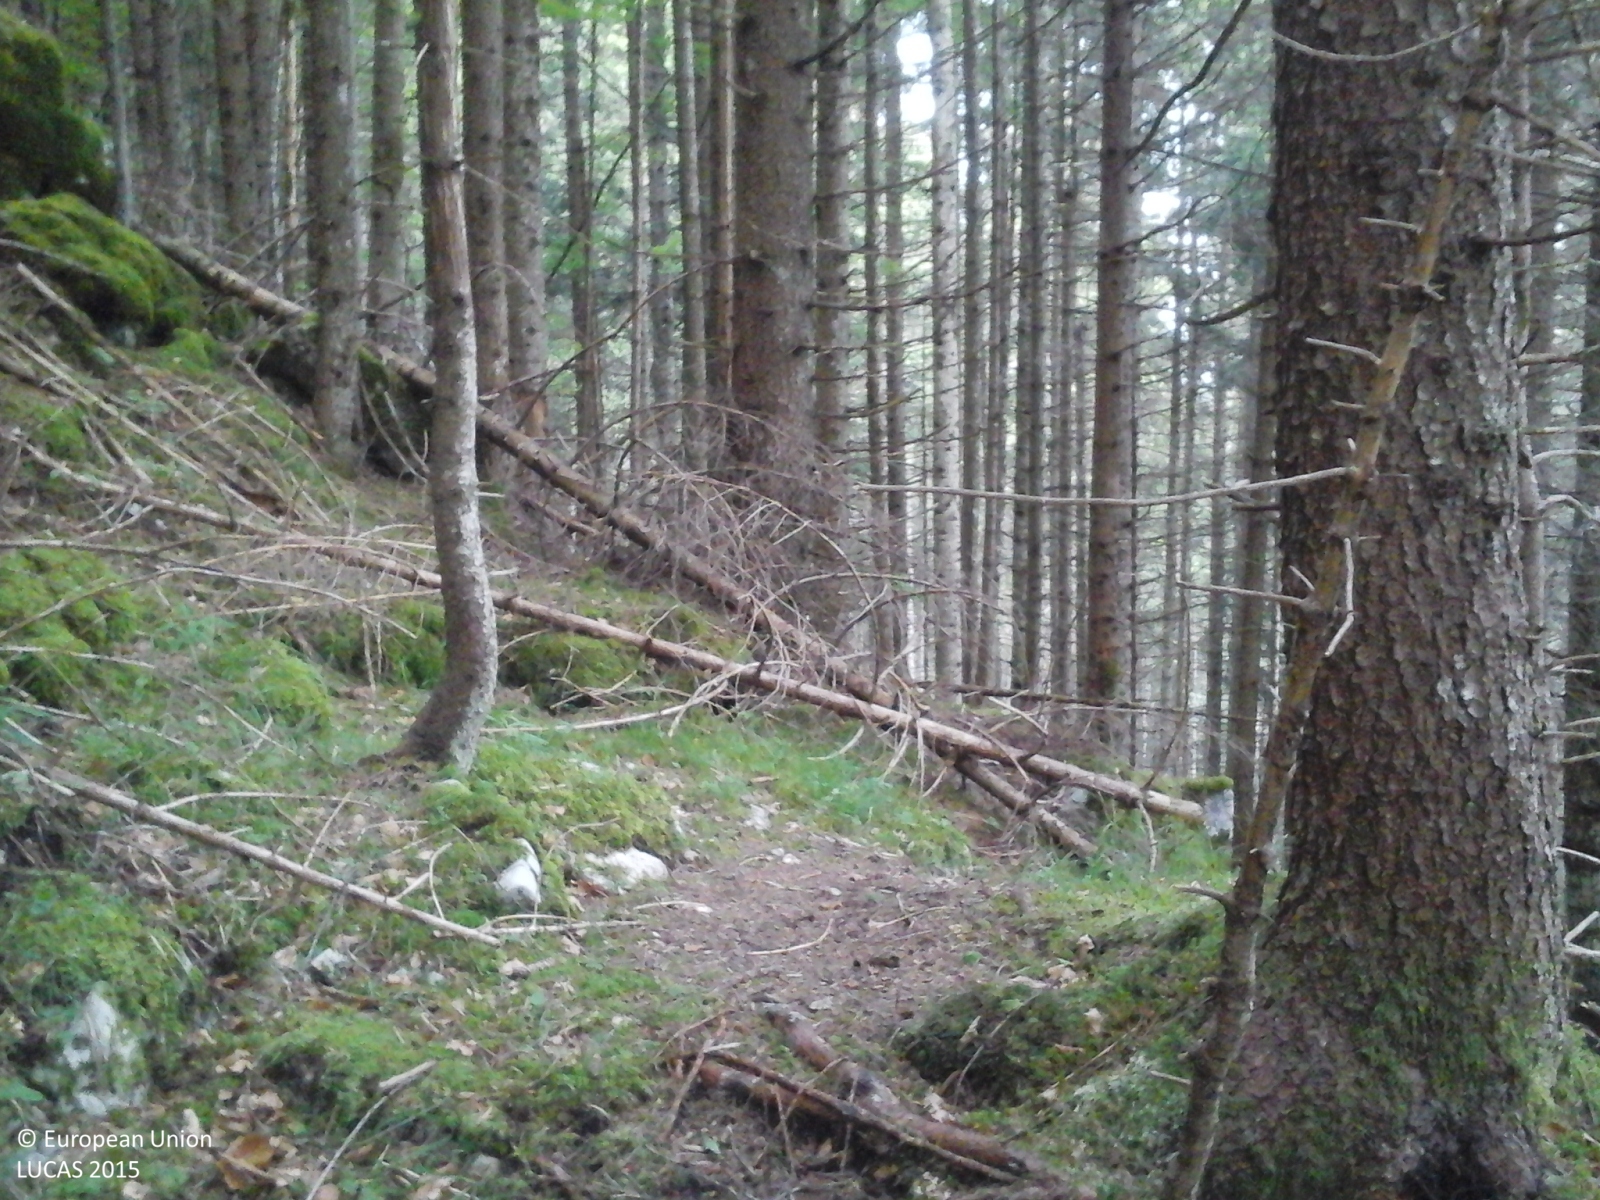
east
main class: Woodland
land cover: Spruce dominated coniferous woodland
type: alpine coniferous forest
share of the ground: > 75 %
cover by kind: coniferous forest trees 100 %
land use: Forestry
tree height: > 5 m
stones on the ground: > 50 %
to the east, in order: Spruce dominated coniferous woodland; Tracks; Spruce dominated coniferous woodland; Tracks; Spruce dominated coniferous woodland; Grassland with sparse tree/shrub cover; Paved roads, cycling and walking lanes
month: June
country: IT
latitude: 45.9456
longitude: 11.4040
